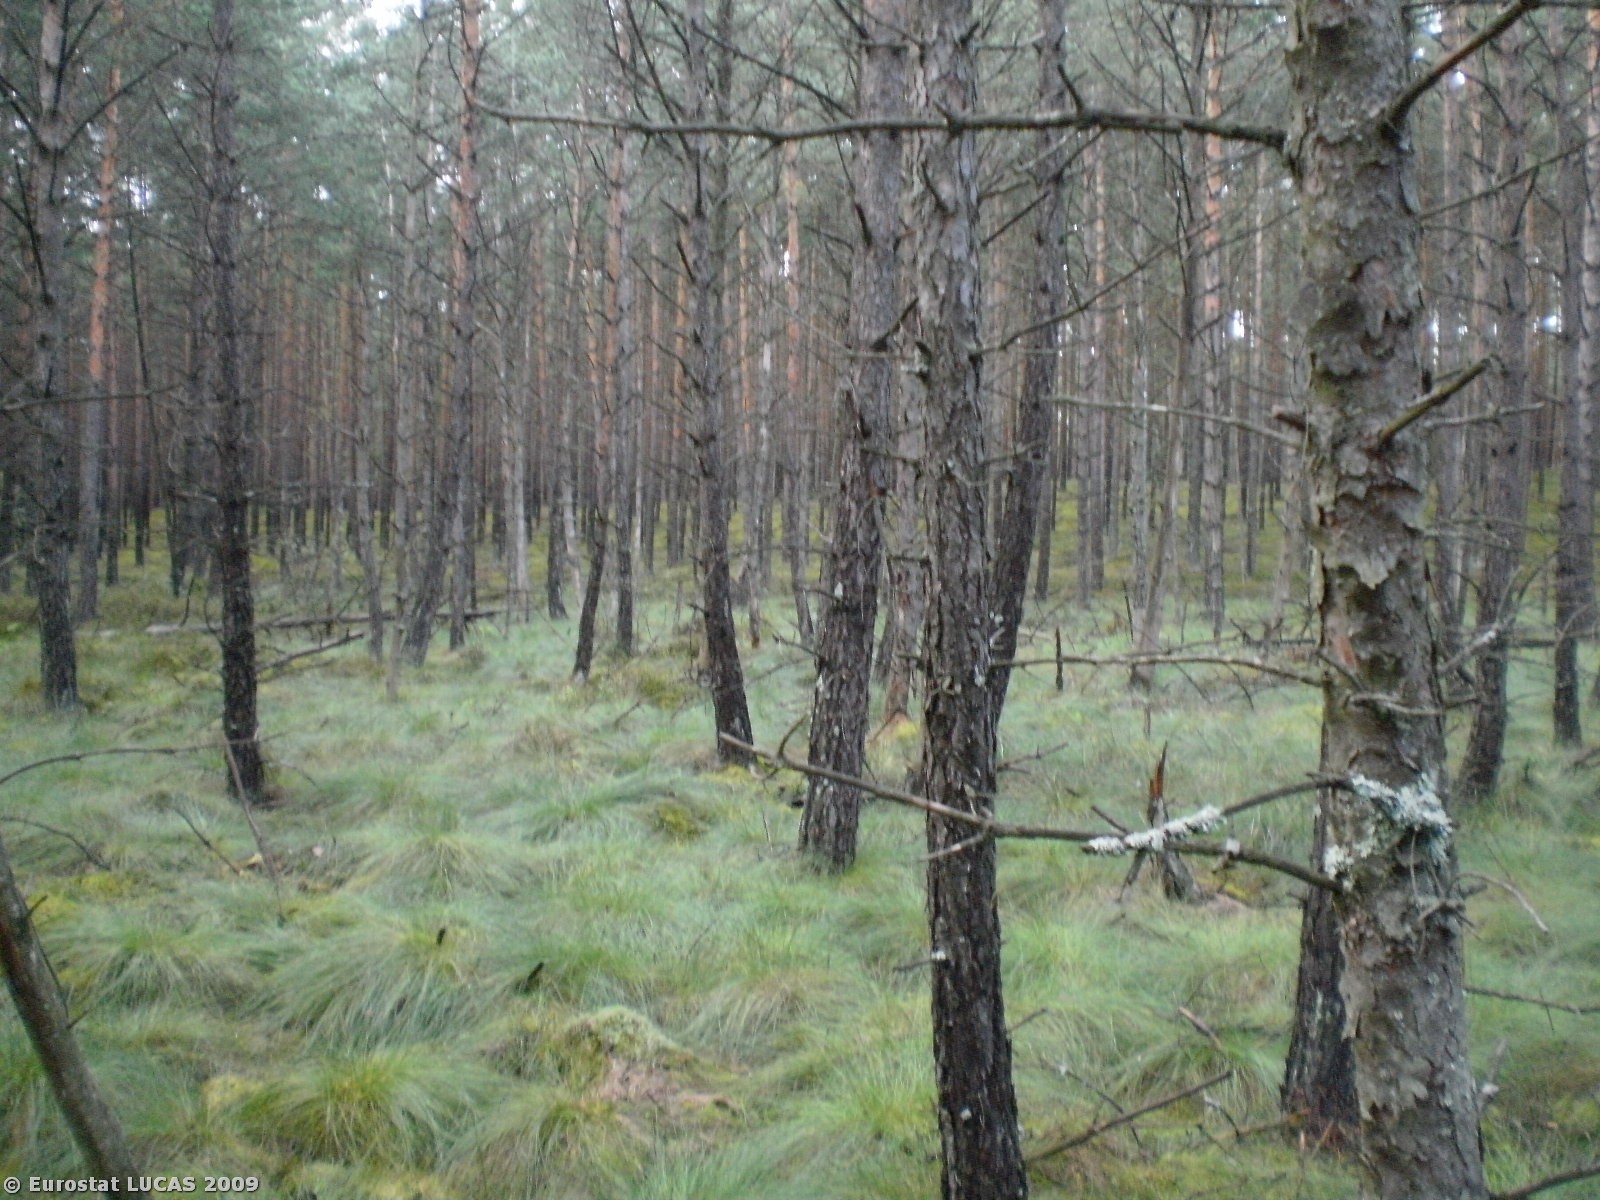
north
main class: Woodland
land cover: Coniferous woodland
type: hemiboreal forest and nemoral coniferous forest and mixed broadleaved-coniferous forest
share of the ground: > 75 %
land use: Forestry
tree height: > 5 m
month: September
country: PL
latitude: 53.7863
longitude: 17.7384
